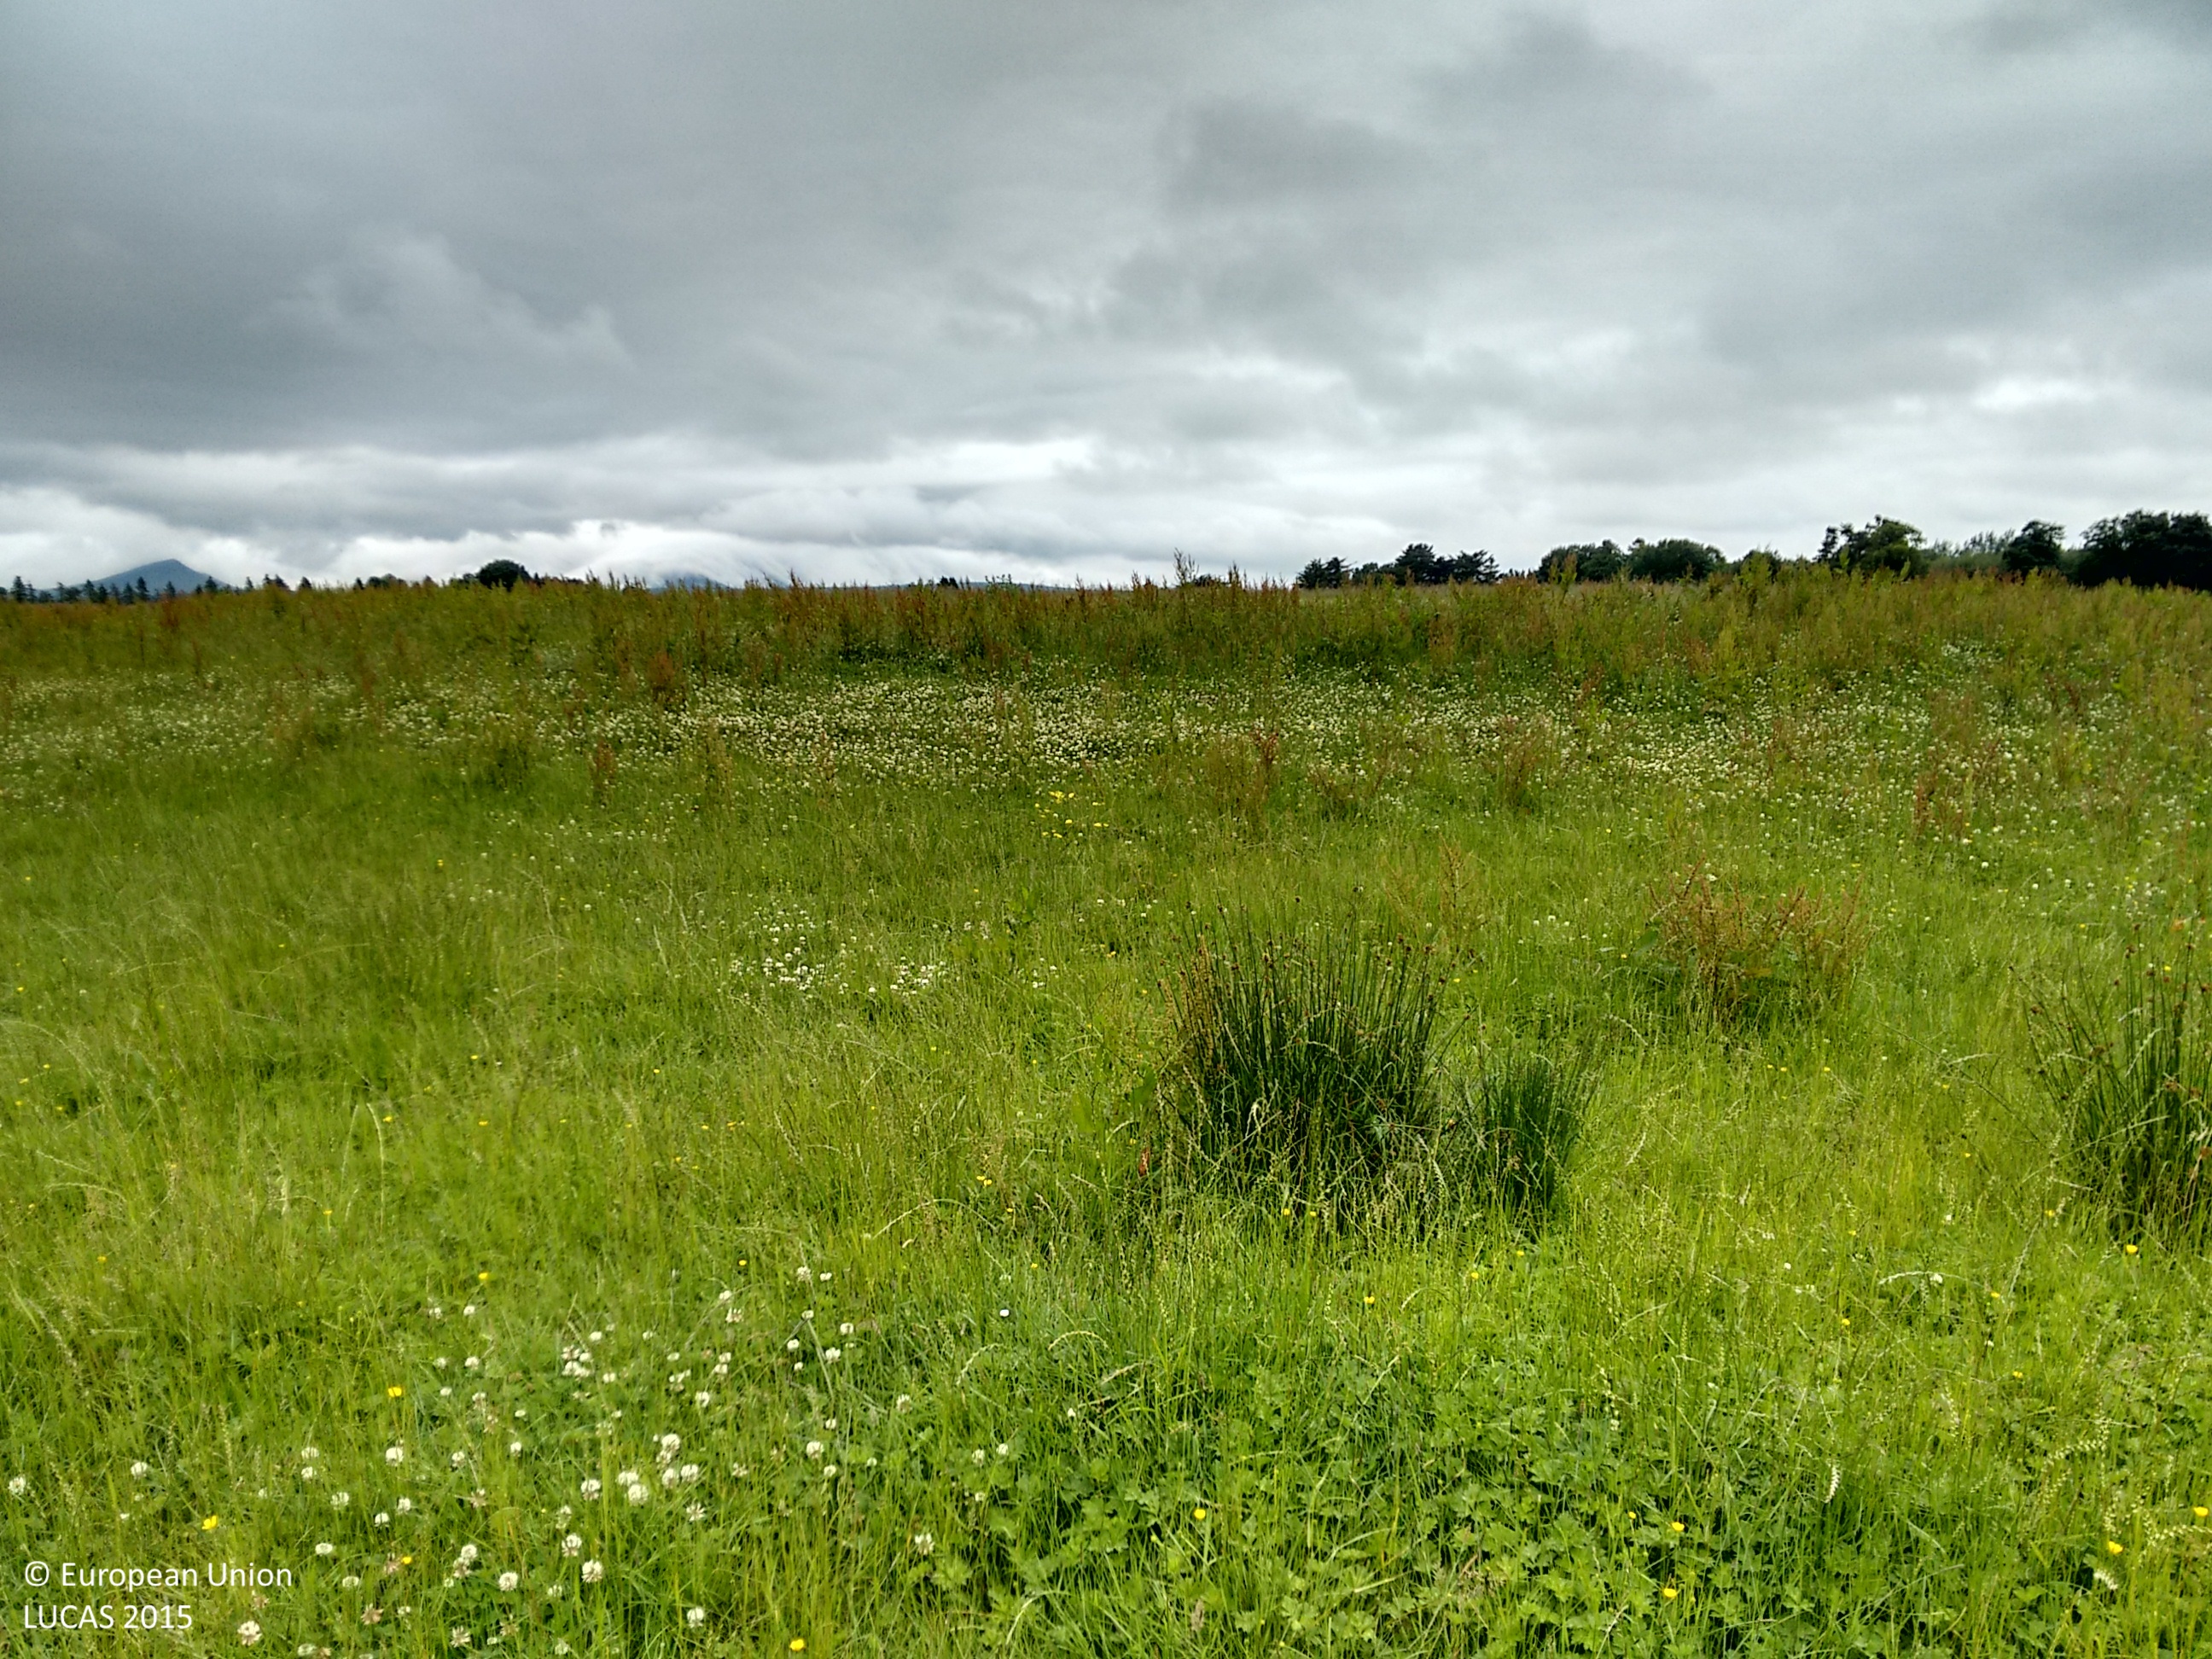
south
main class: Grassland
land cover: Grassland without tree/shrub cover
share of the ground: > 75 %
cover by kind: herbaceous plants 100 %
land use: Agriculture (excluding fallow land and kitchen gardens)
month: July
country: IE
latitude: 52.4989
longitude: -8.2289
